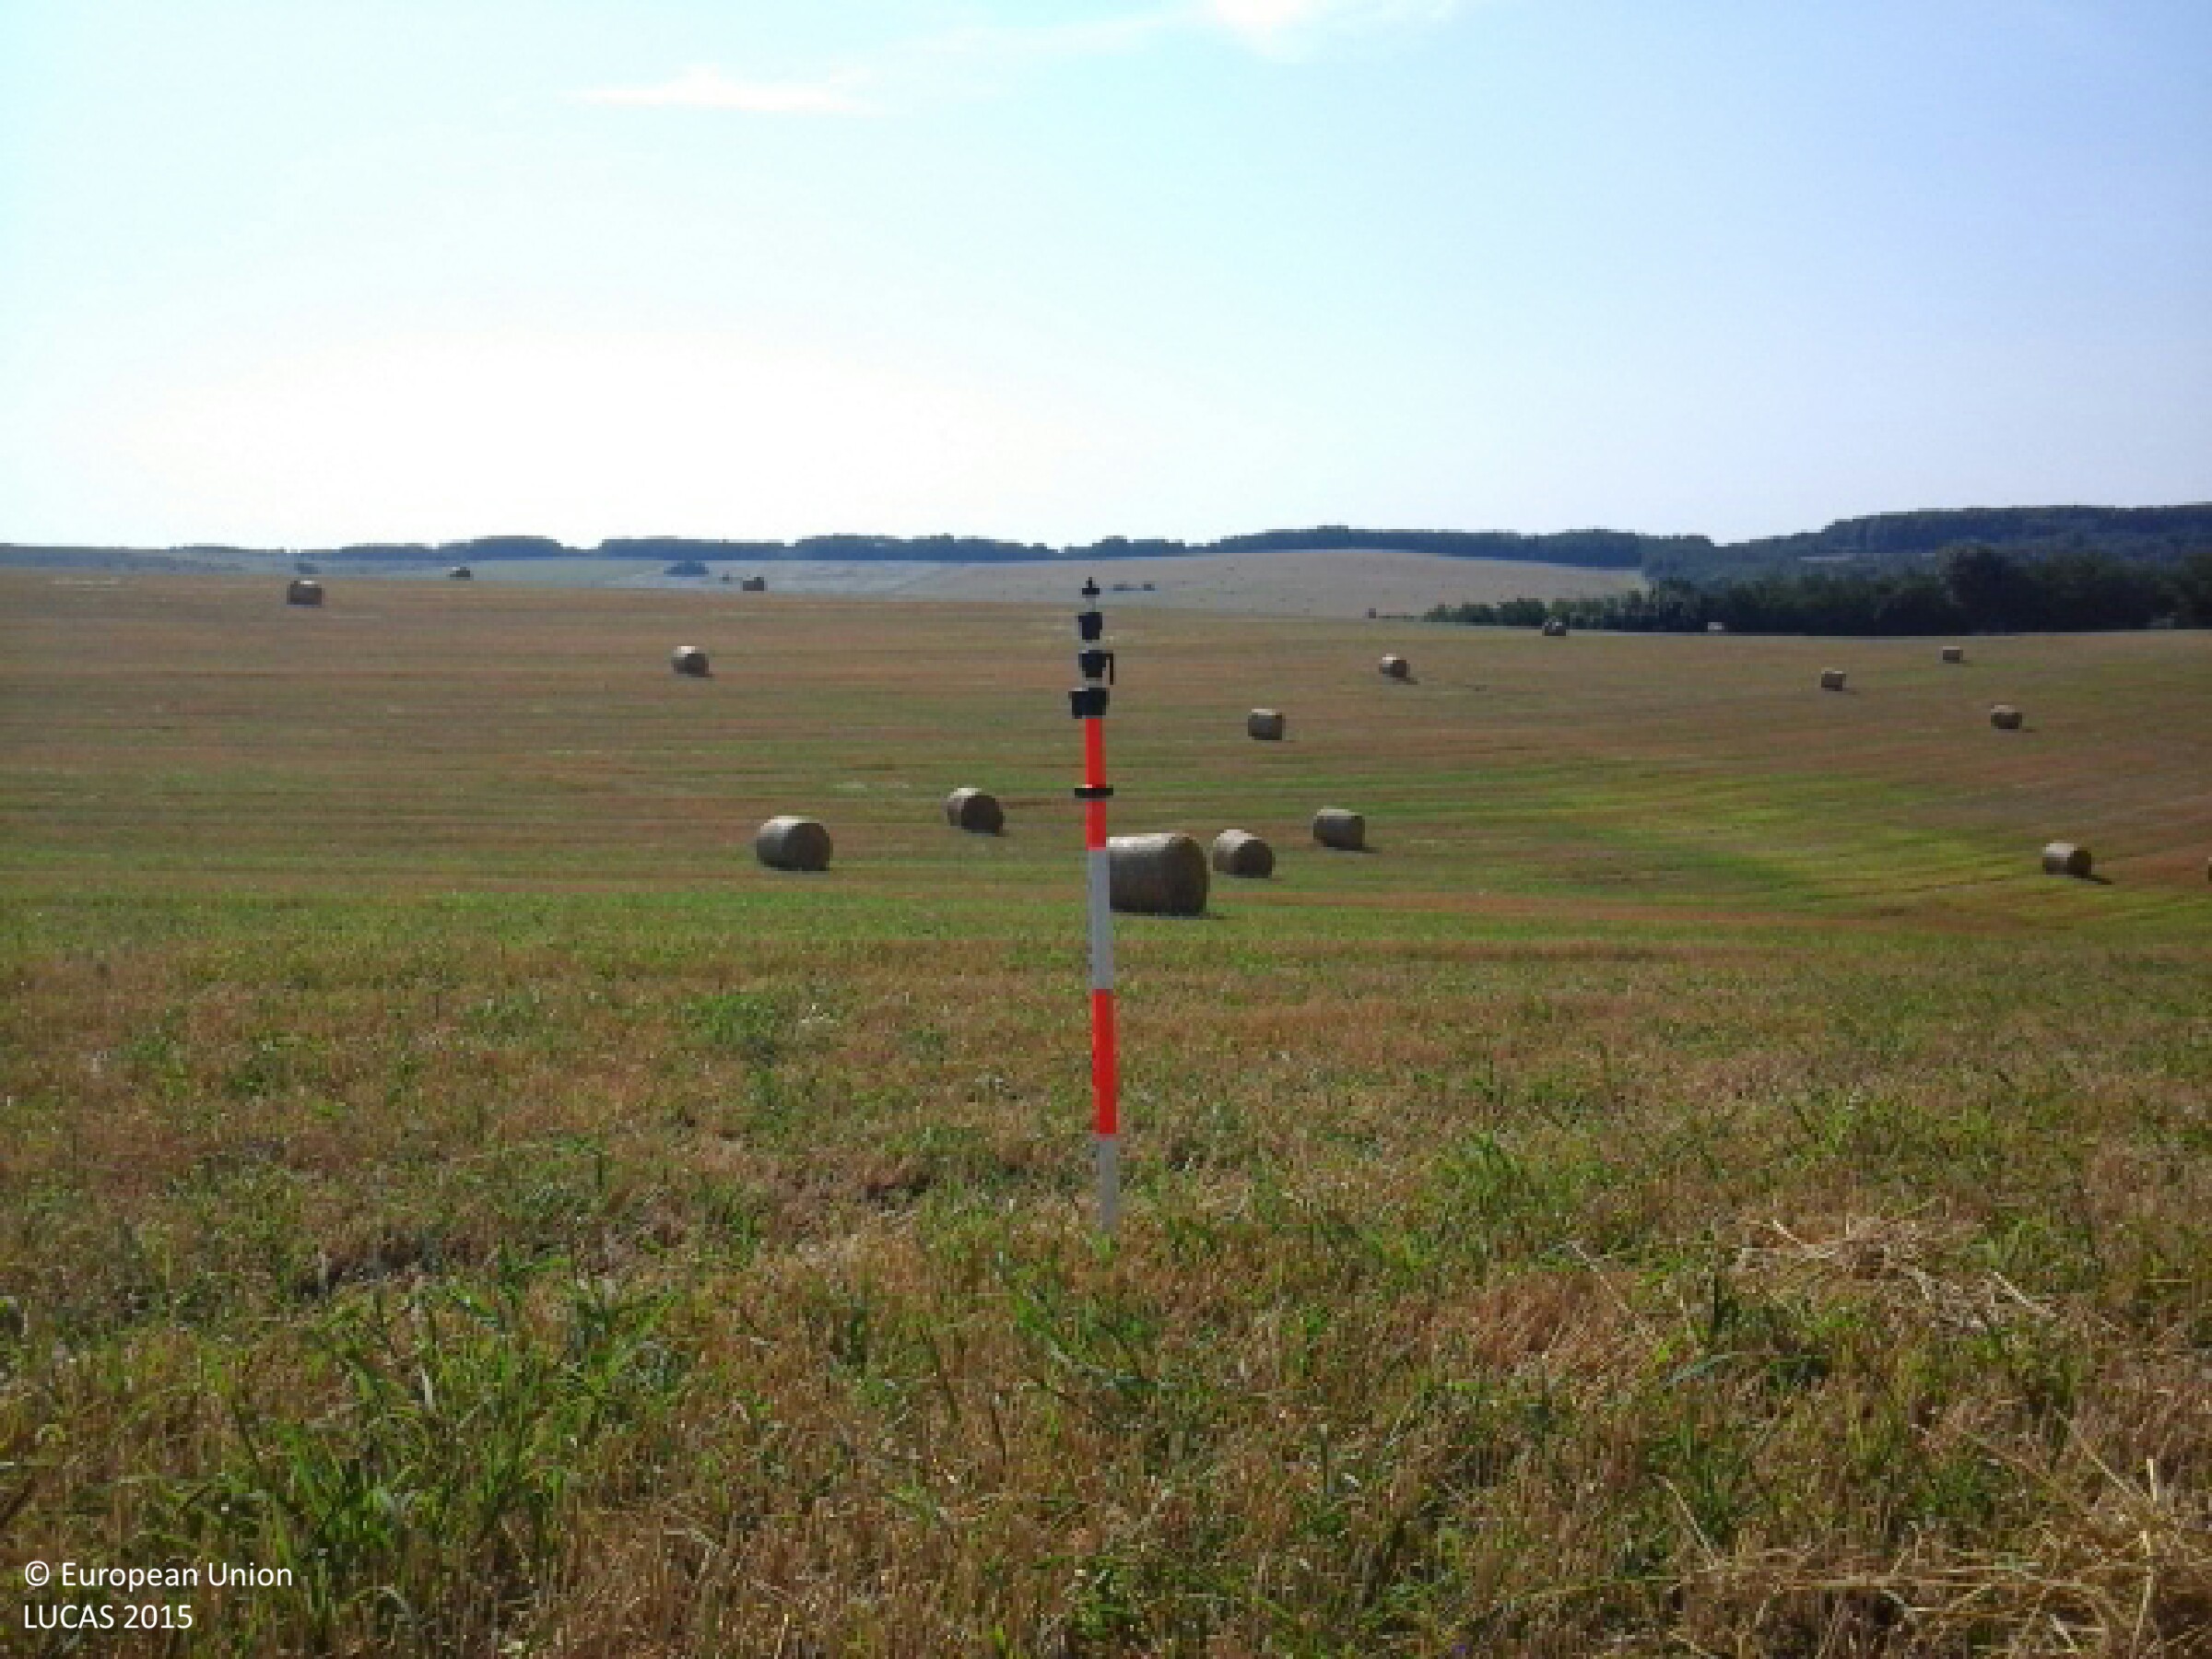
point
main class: Cropland
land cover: Triticale
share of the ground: 10 - 25 %
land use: Agriculture (excluding fallow land and kitchen gardens)
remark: Harvested field
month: July
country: HU
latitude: 48.5198
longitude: 21.0485
